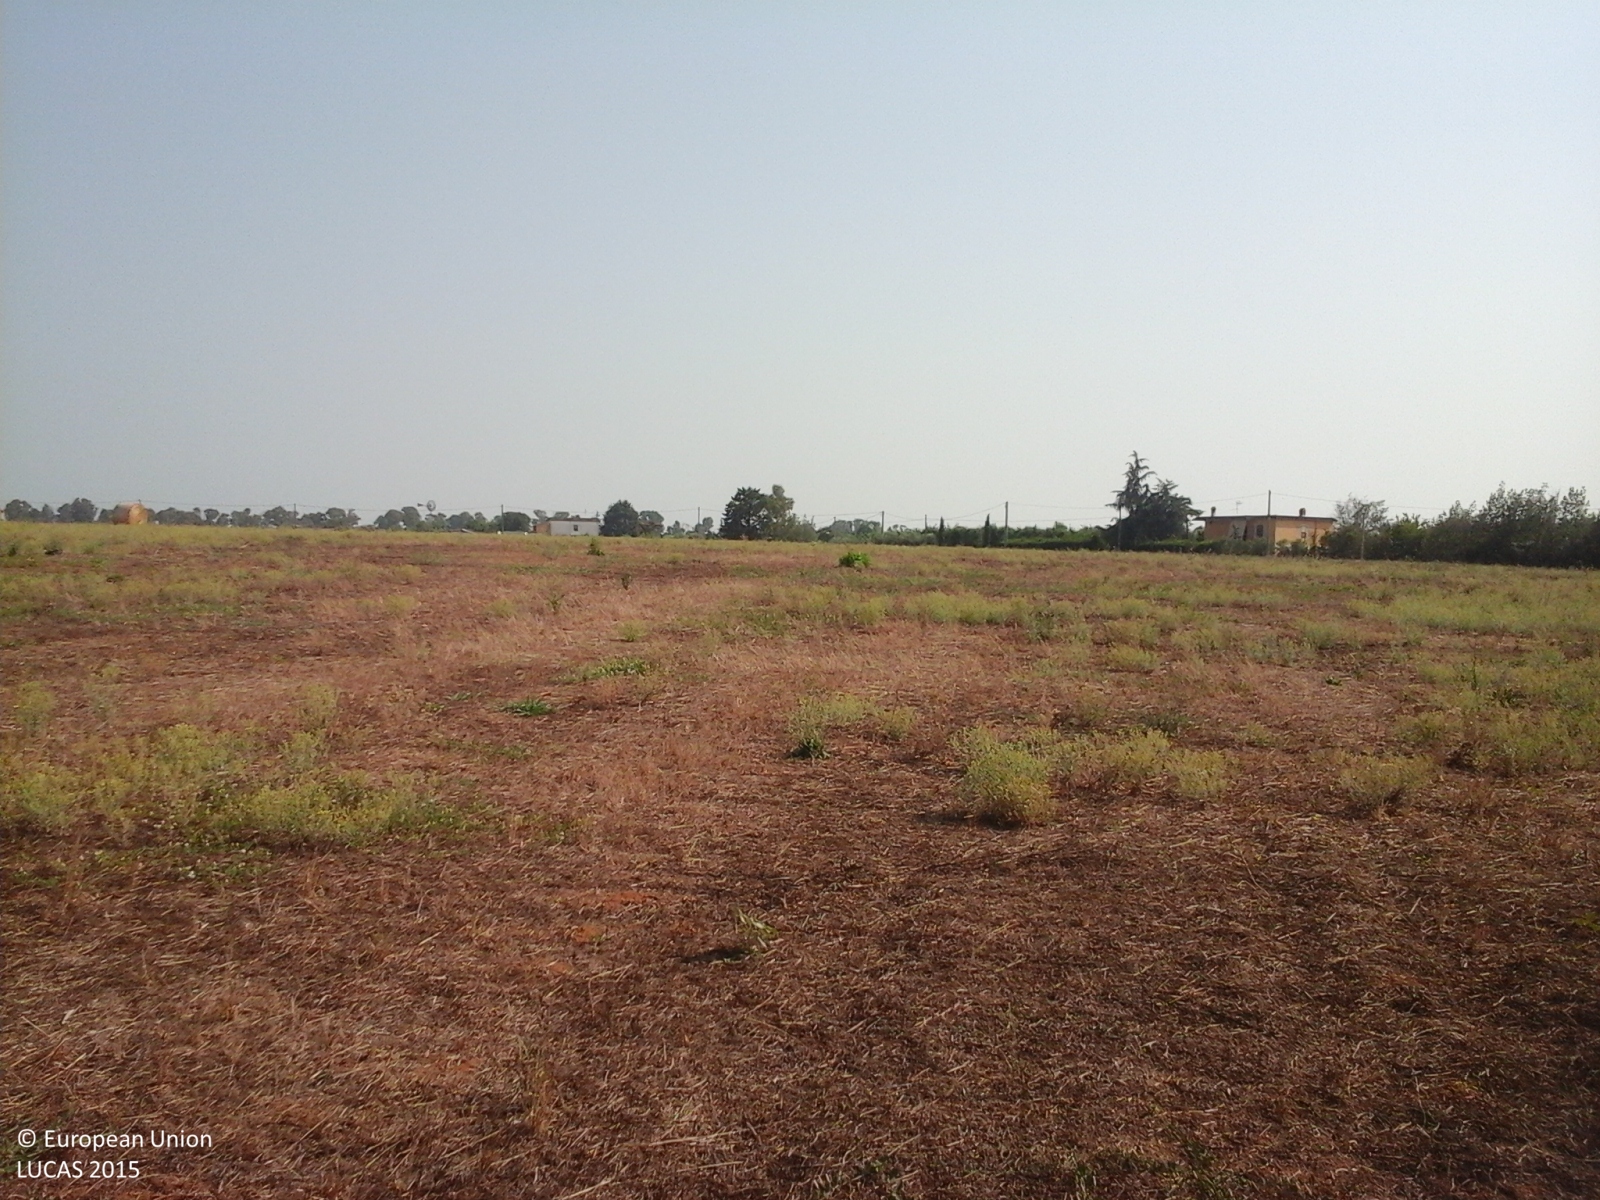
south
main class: Cropland
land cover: Durum wheat
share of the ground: > 75 %
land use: Agriculture (excluding fallow land and kitchen gardens)
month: July
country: IT
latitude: 41.4950
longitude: 12.7799
